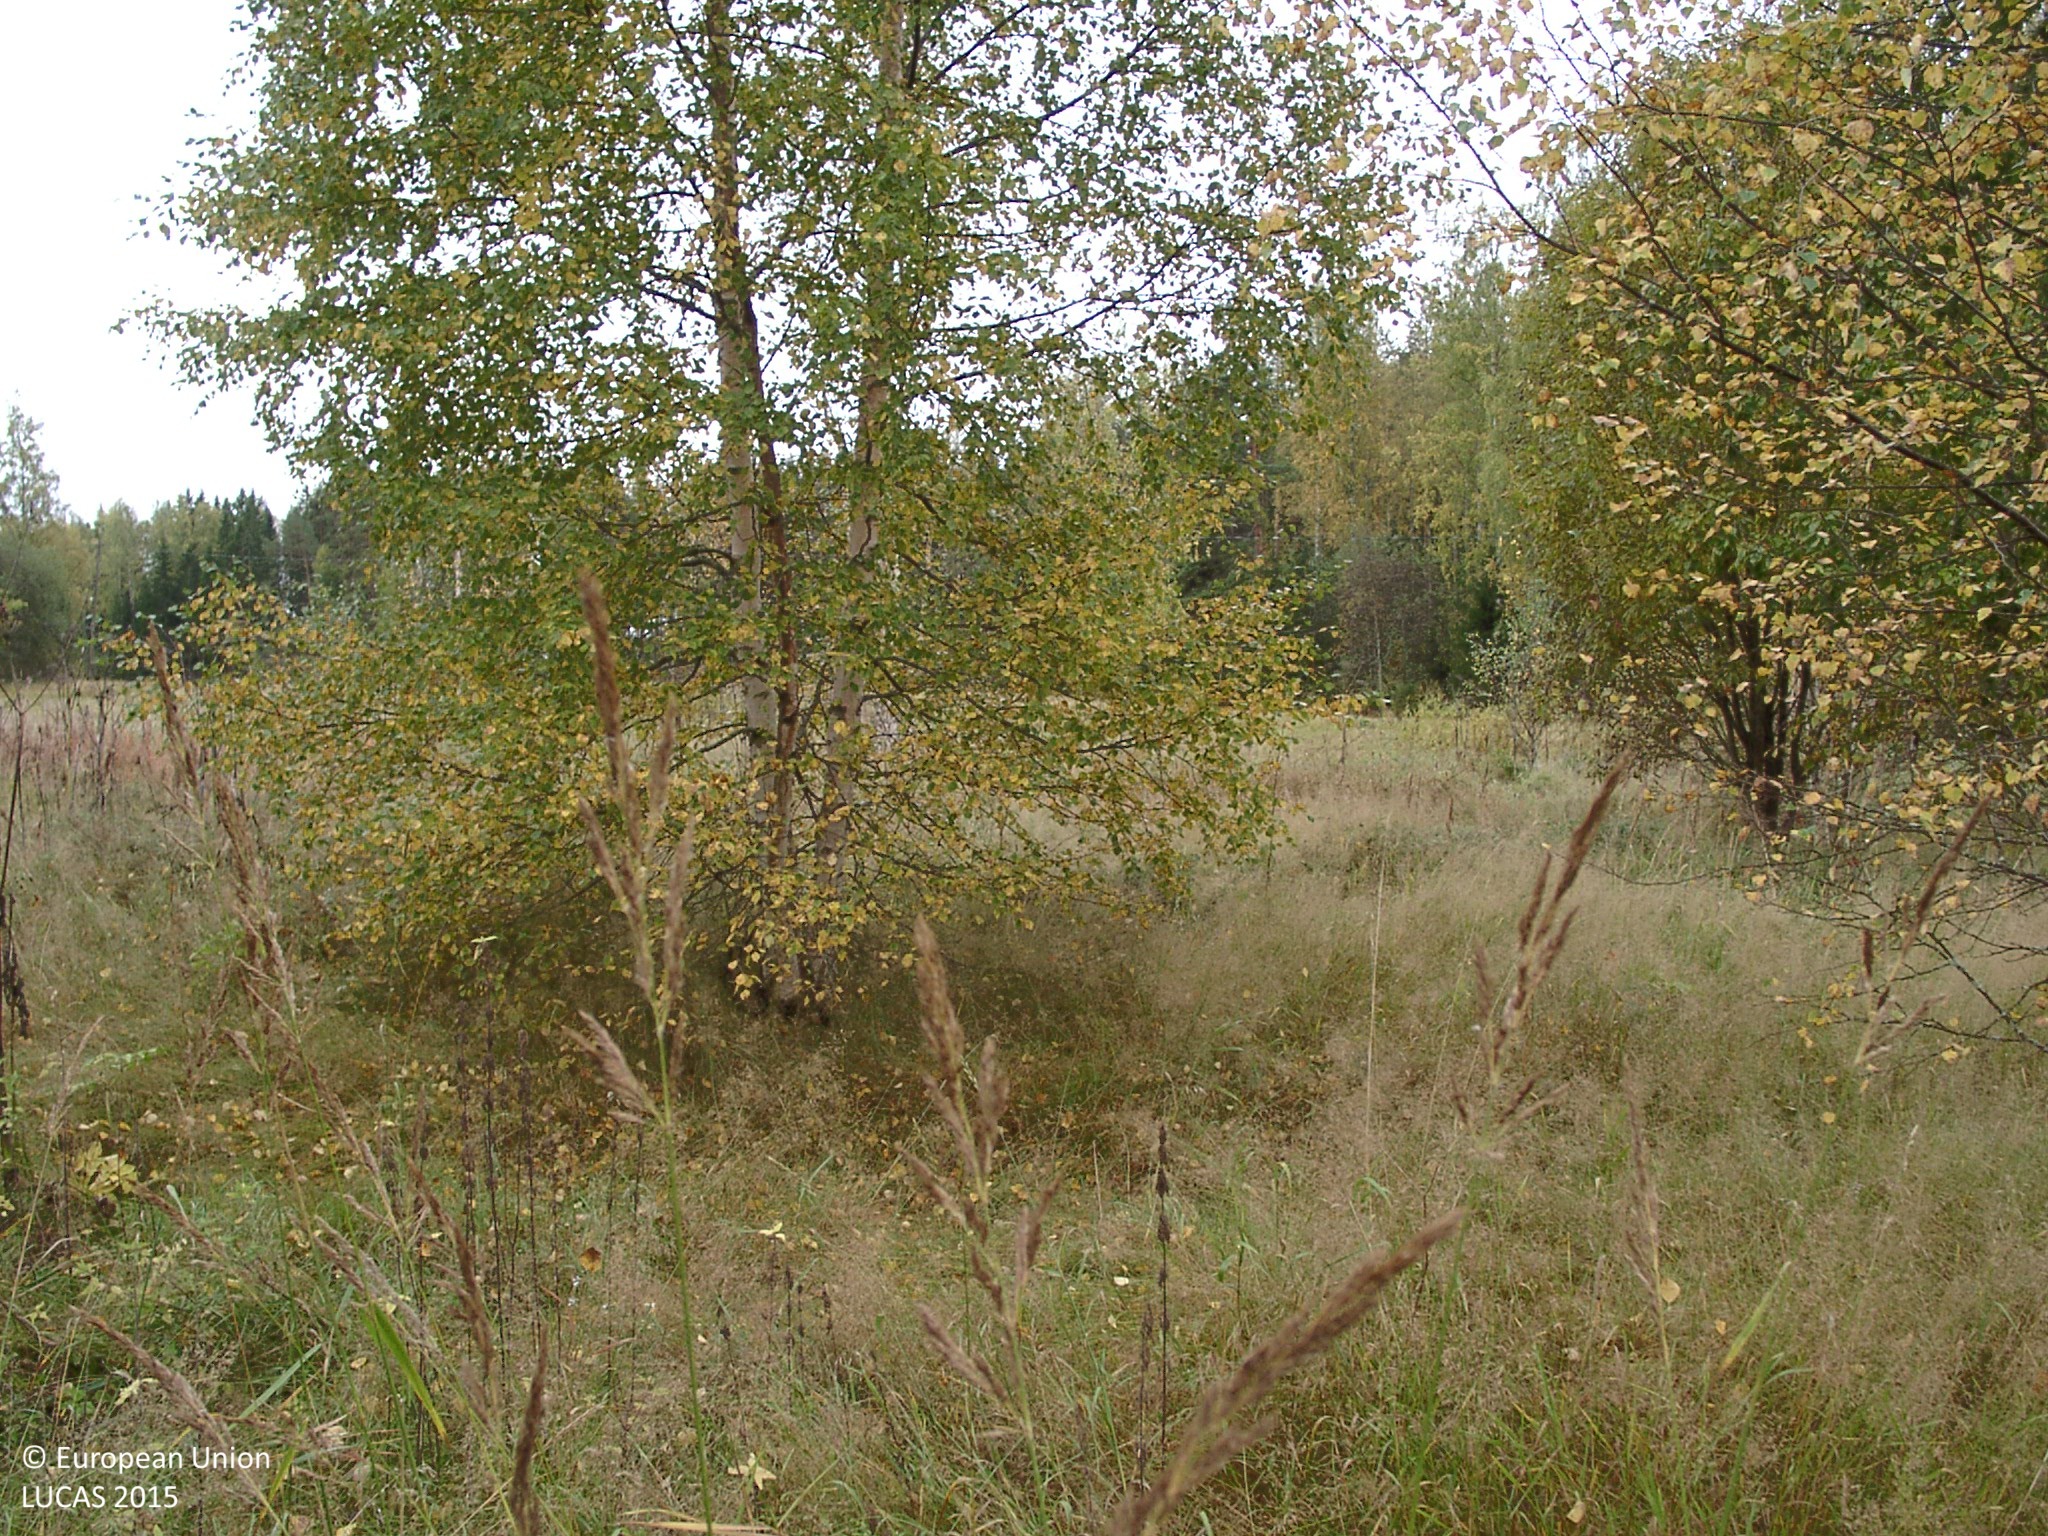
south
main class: Grassland
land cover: Grassland with sparse tree/shrub cover
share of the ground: > 75 %
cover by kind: herbaceous plants 90 %, broadleaved forest trees 5 %, shrubs 5 %
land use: Semi-natural and natural areas not in use
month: September
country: FI
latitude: 62.7188
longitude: 25.3799
